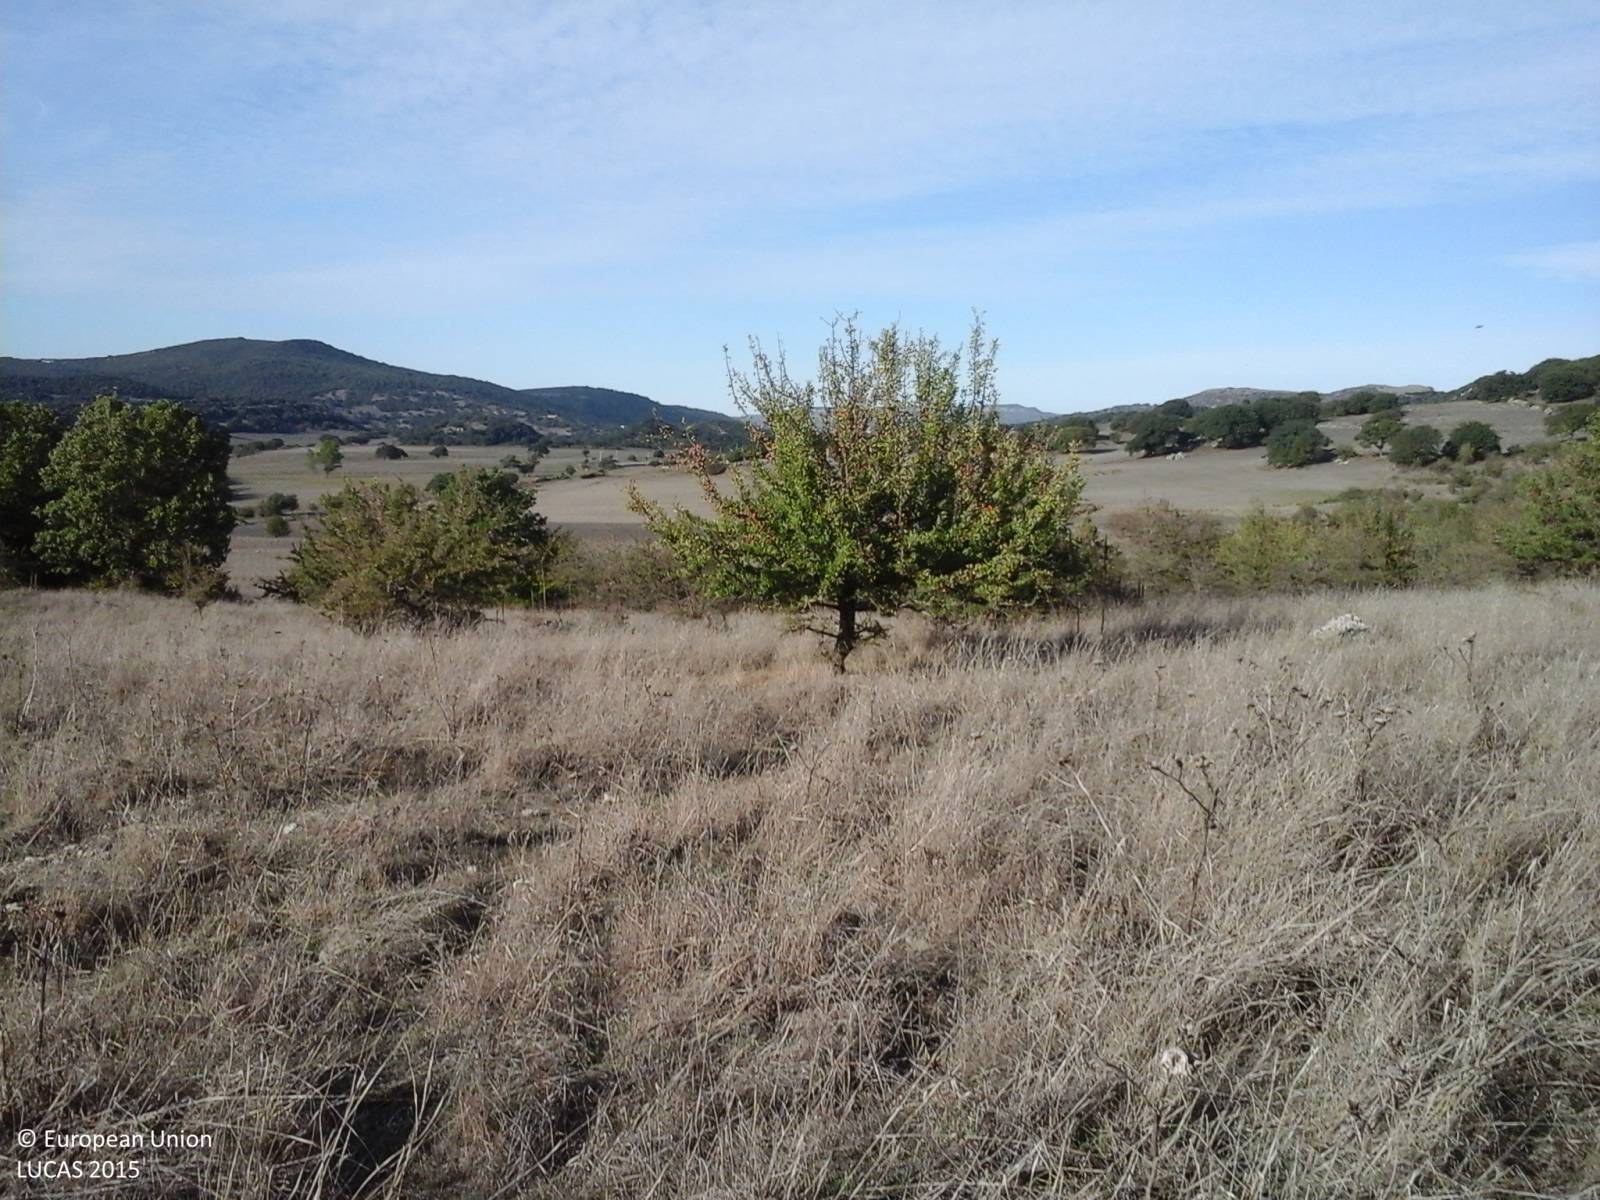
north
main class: Grassland
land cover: Grassland without tree/shrub cover
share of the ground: > 75 %
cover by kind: herbaceous plants 100 %
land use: Agriculture (excluding fallow land and kitchen gardens)
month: October
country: IT
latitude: 40.4019
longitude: 8.5815
